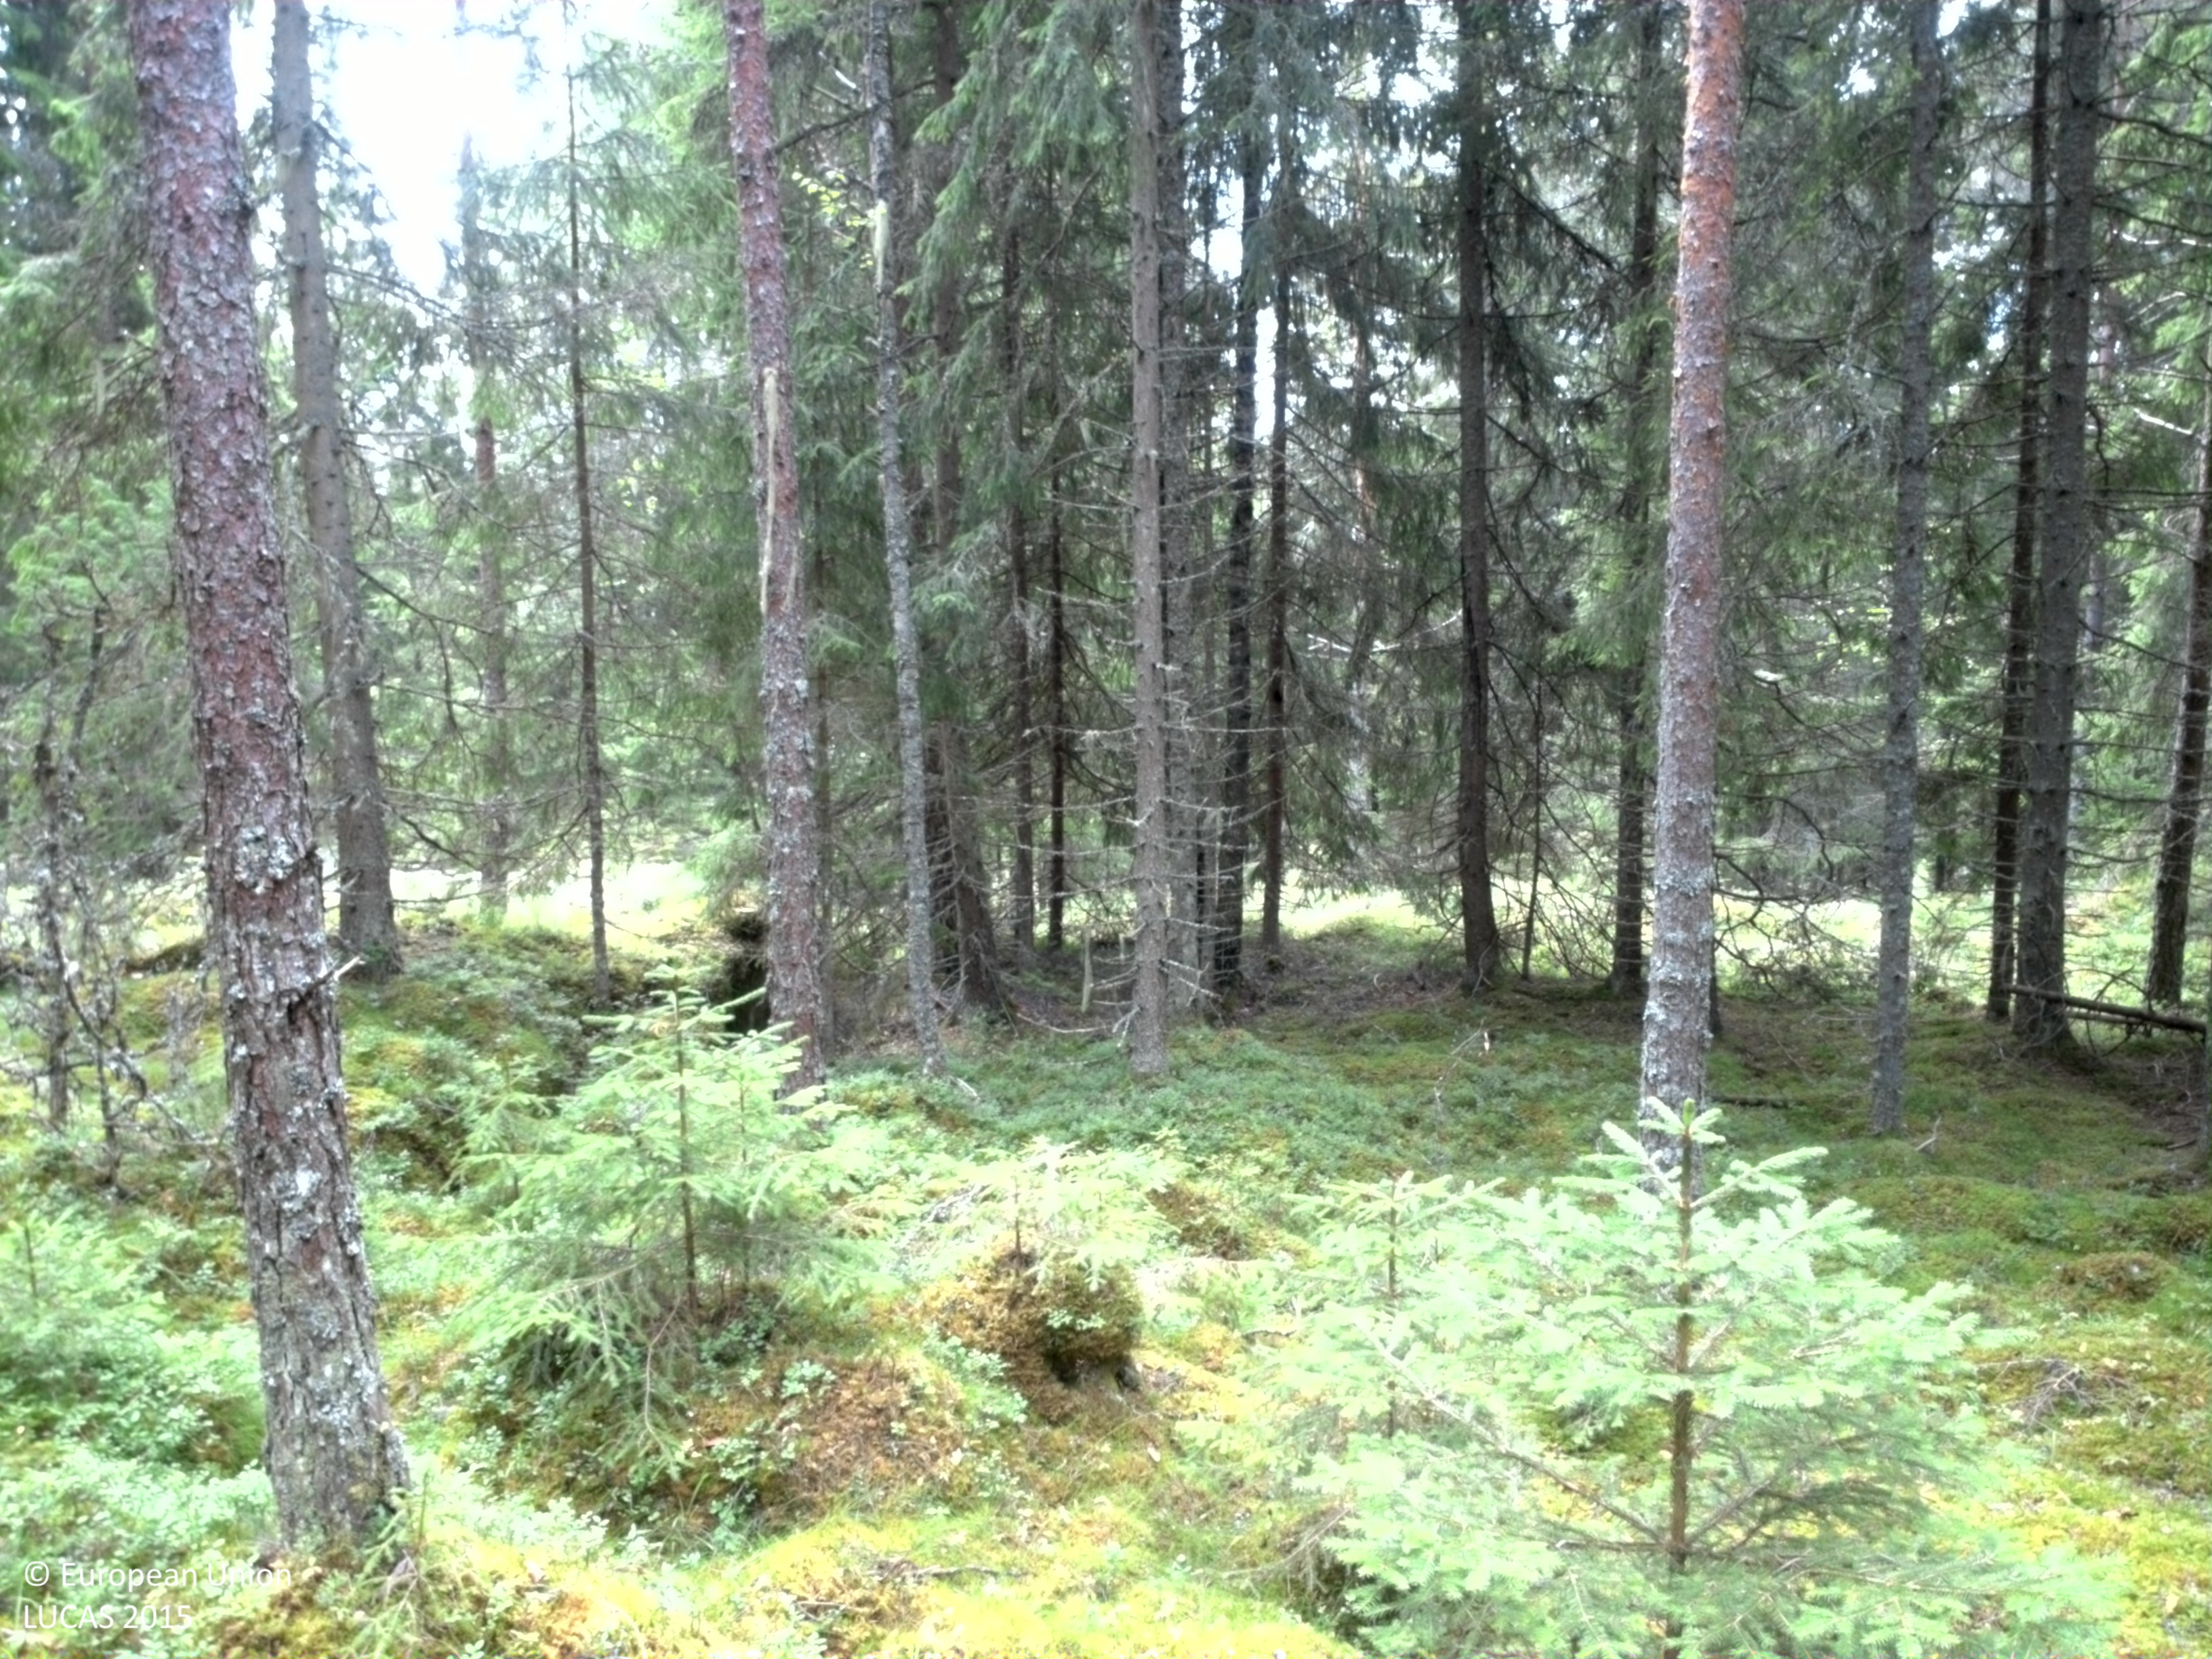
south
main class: Woodland
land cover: Pine dominated coniferous woodland
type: boreal forest
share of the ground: 50 - 75 %
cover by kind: coniferous forest trees 55 %, shrubs 20 %, lichens and mosses 20 %, broadleaved forest trees 5 %
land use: Forestry
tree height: > 5 m
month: July
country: SE
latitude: 59.4475
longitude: 11.9174
